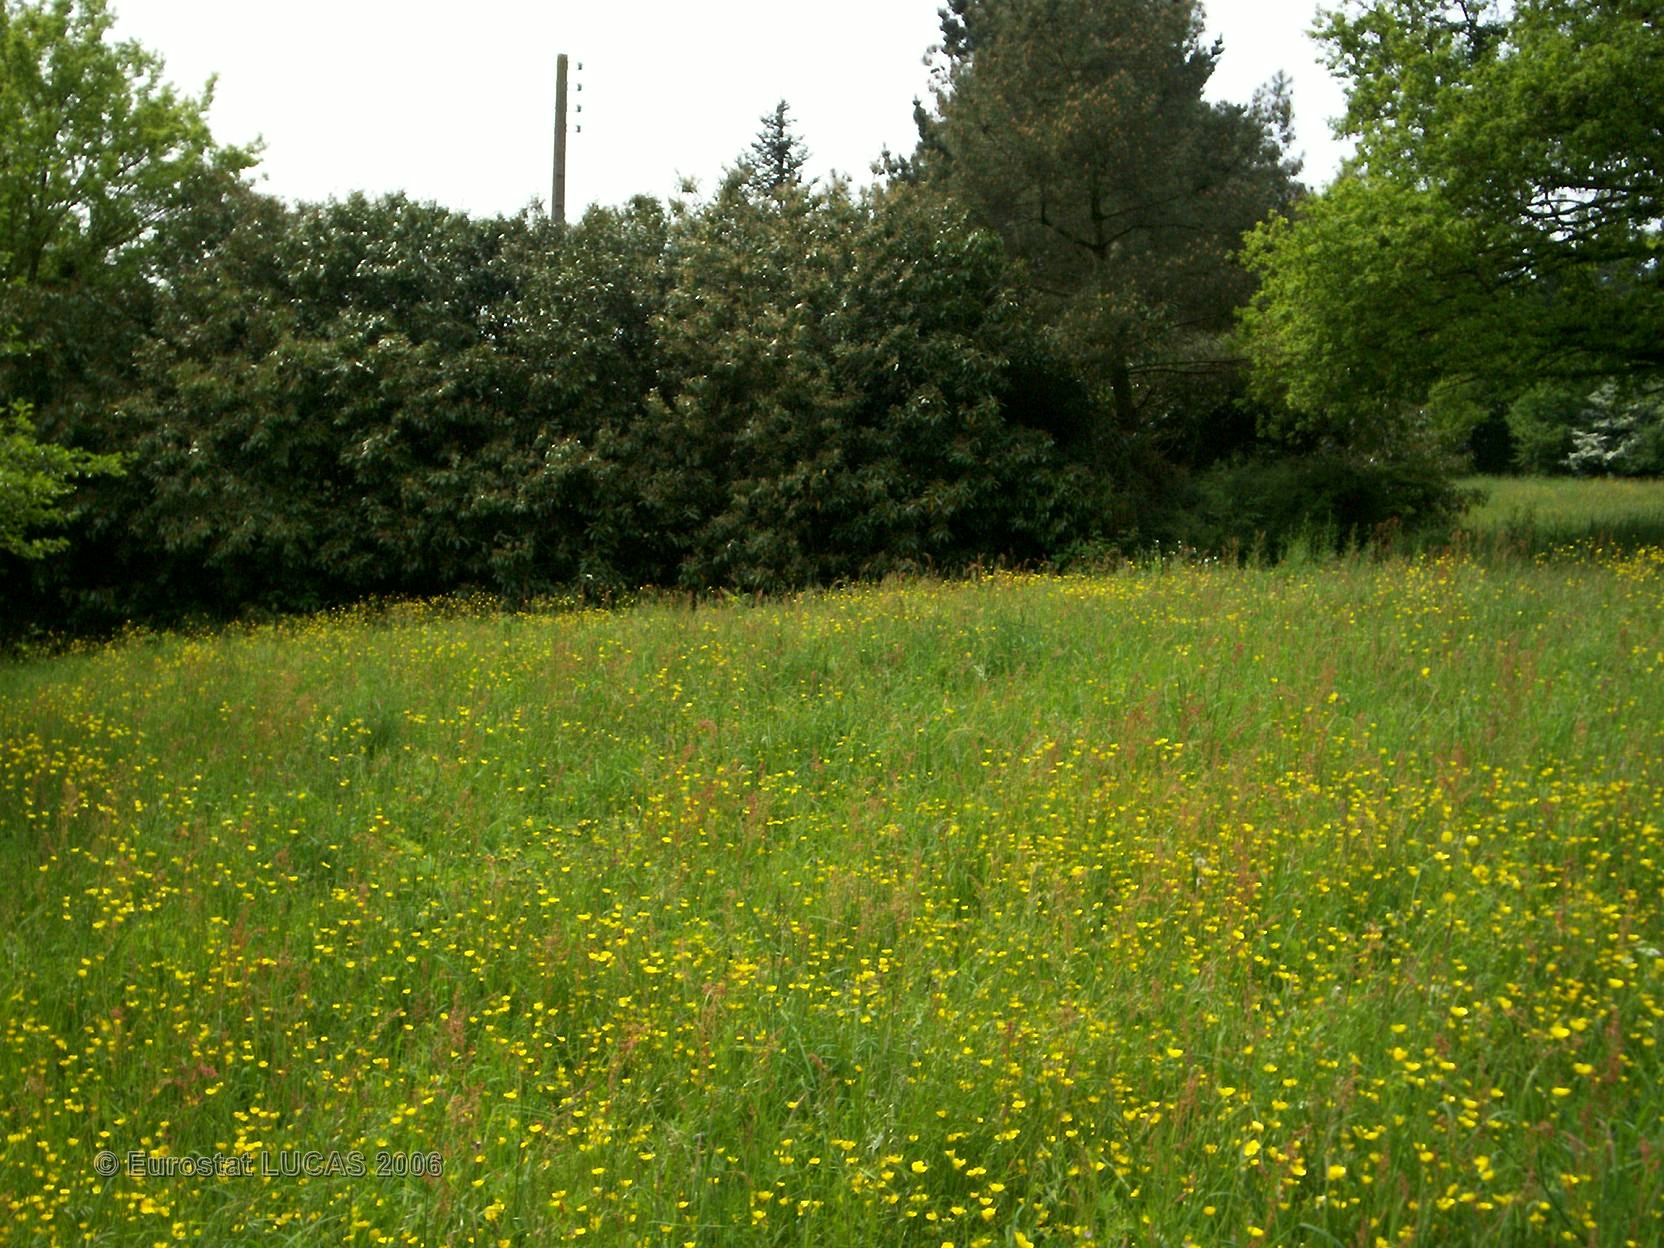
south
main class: Grassland
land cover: Grassland without tree/shrub cover
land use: Agriculture (excluding fallow land and kitchen gardens)
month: May
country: FR
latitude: 47.7083
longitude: -1.5193
